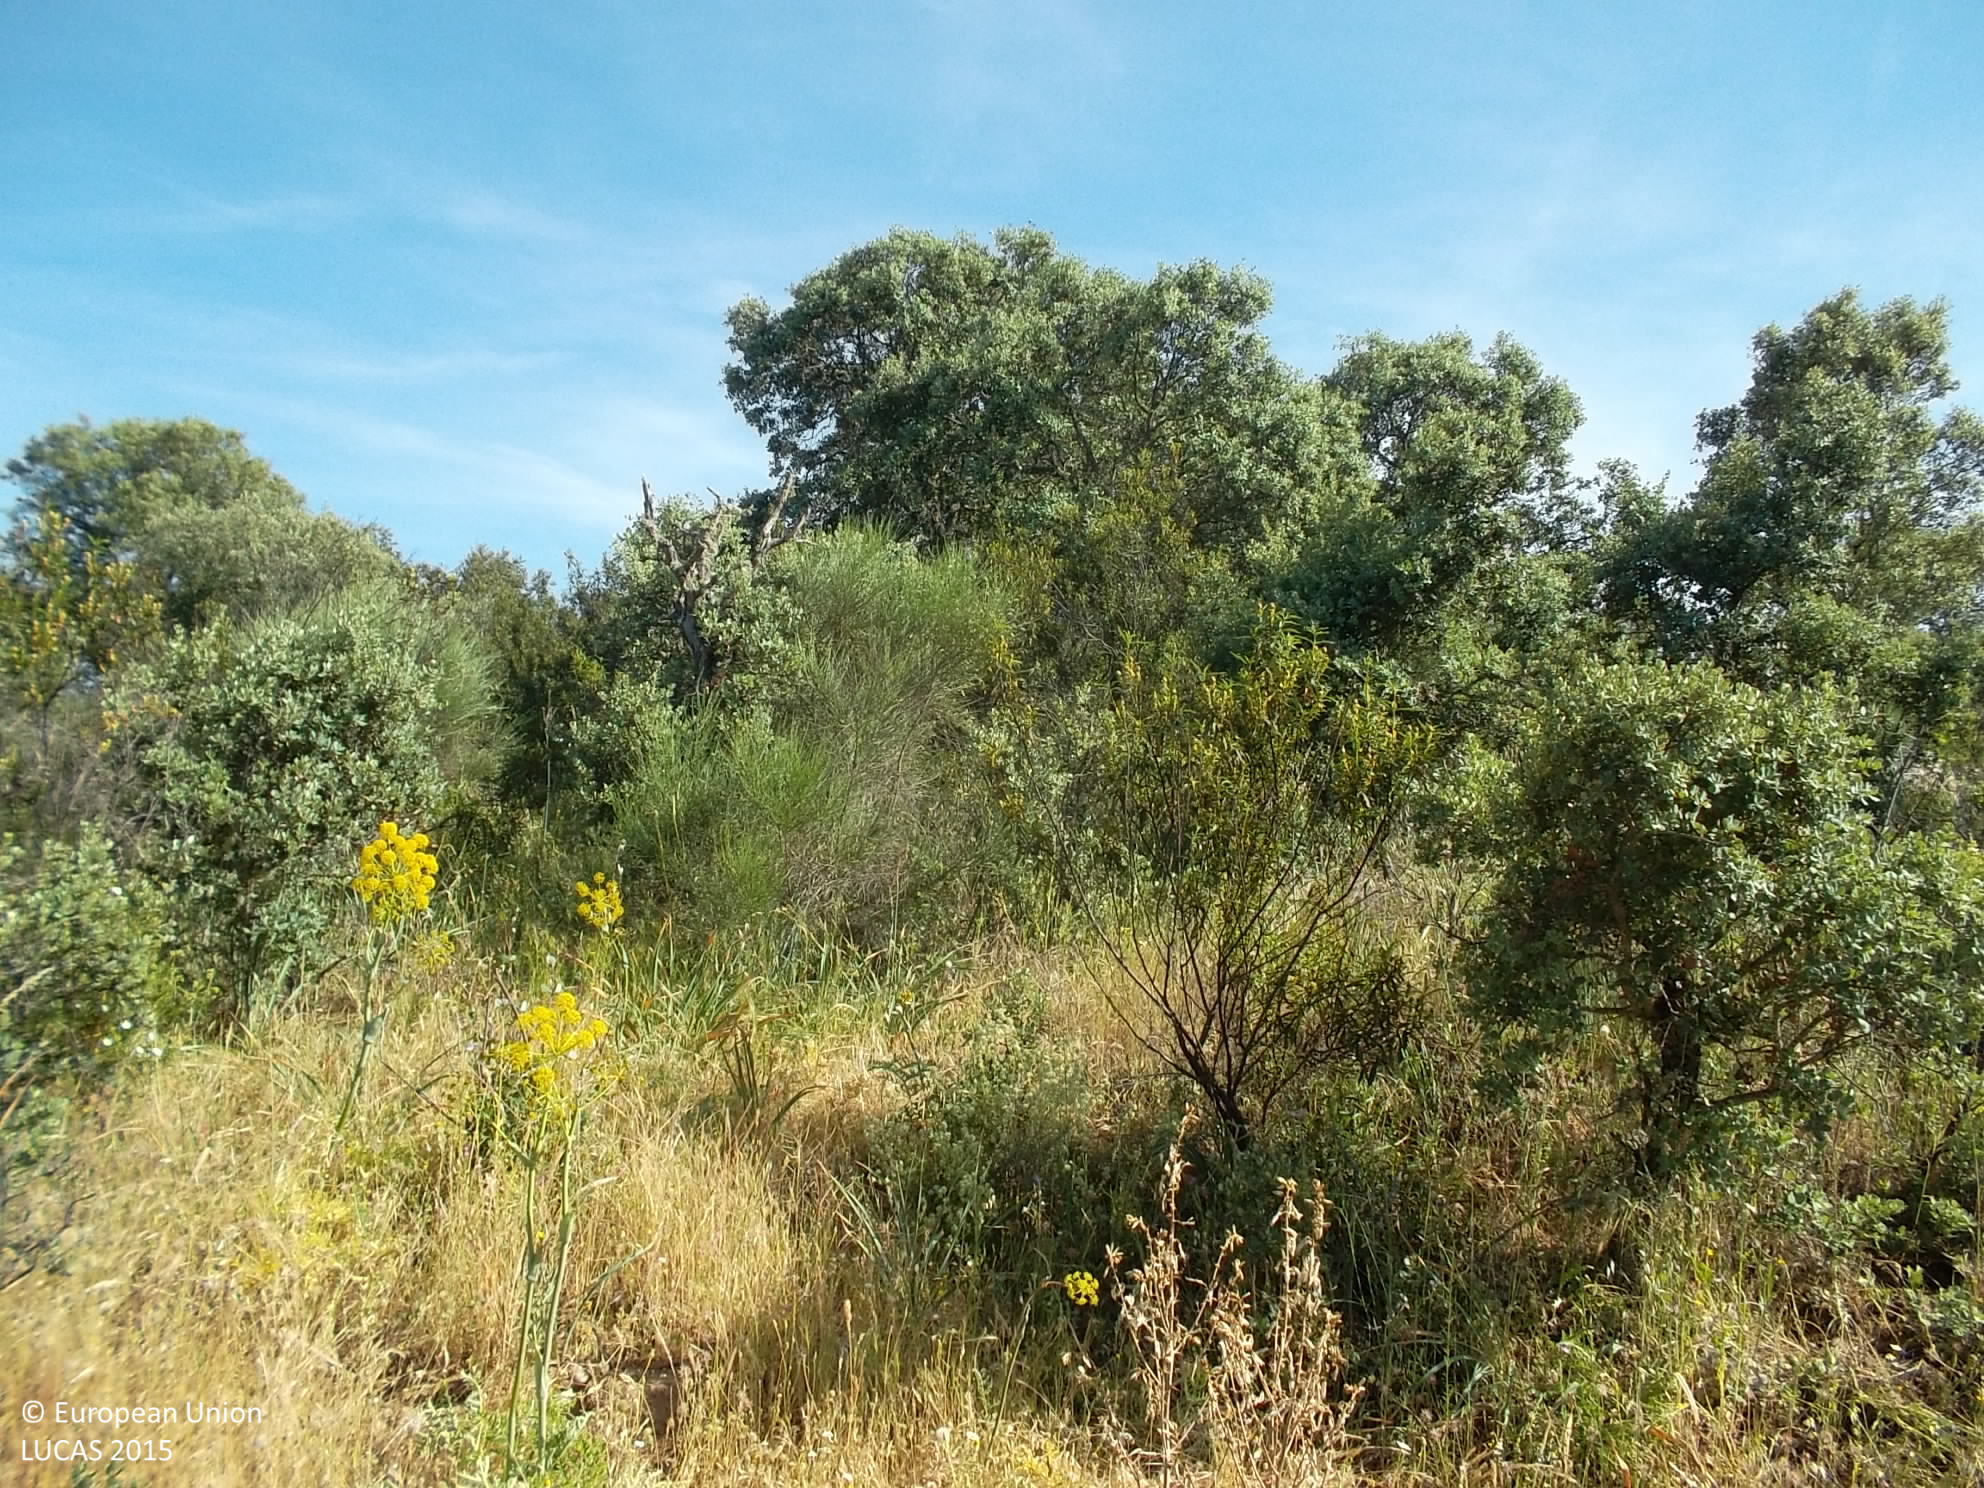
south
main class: Woodland
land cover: Broadleaved woodland
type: broadleaved evergreen forest
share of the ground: 25 - 50 %
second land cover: Shrubland without tree cover
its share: 50 - 75 %
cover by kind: broadleaved forest trees 40 %, shrubs 40 %, herbaceous plants 20 %
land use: Forestry
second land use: Agriculture (excluding fallow land and kitchen gardens)
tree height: < 5 m
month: May
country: ES
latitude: 38.7773
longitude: -4.5171
